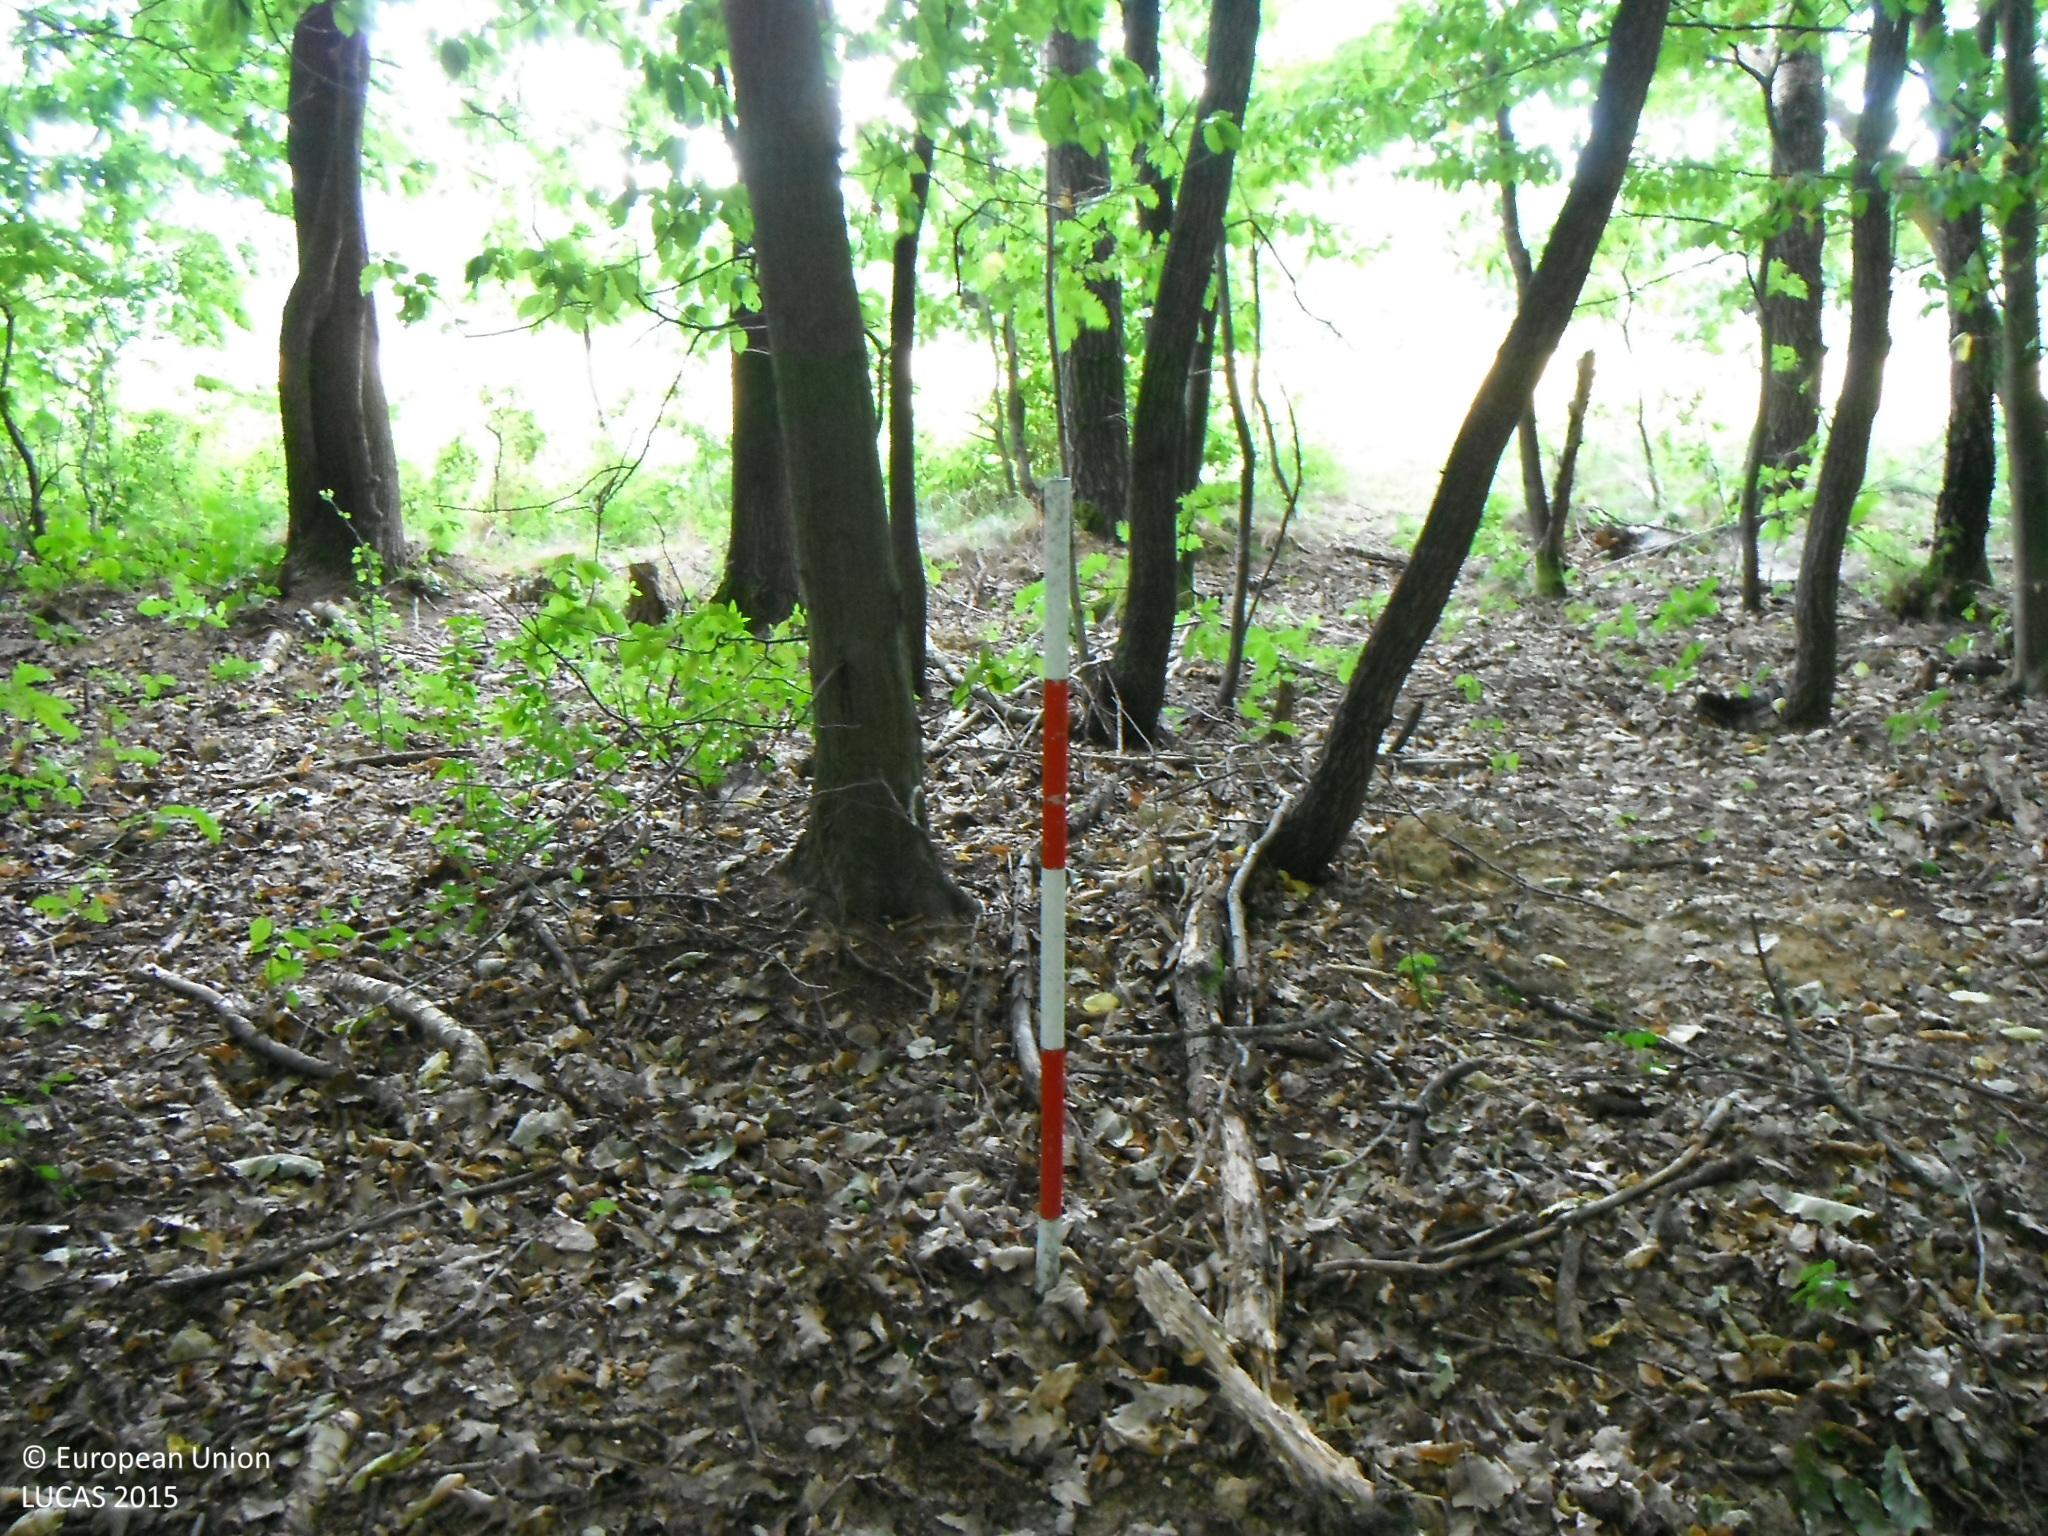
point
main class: Woodland
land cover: Broadleaved woodland
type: mesophytic deciduous forest
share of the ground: > 75 %
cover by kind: broadleaved forest trees 100 %
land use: Forestry
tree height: > 5 m
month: July
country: SK
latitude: 48.3300
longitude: 19.9972
